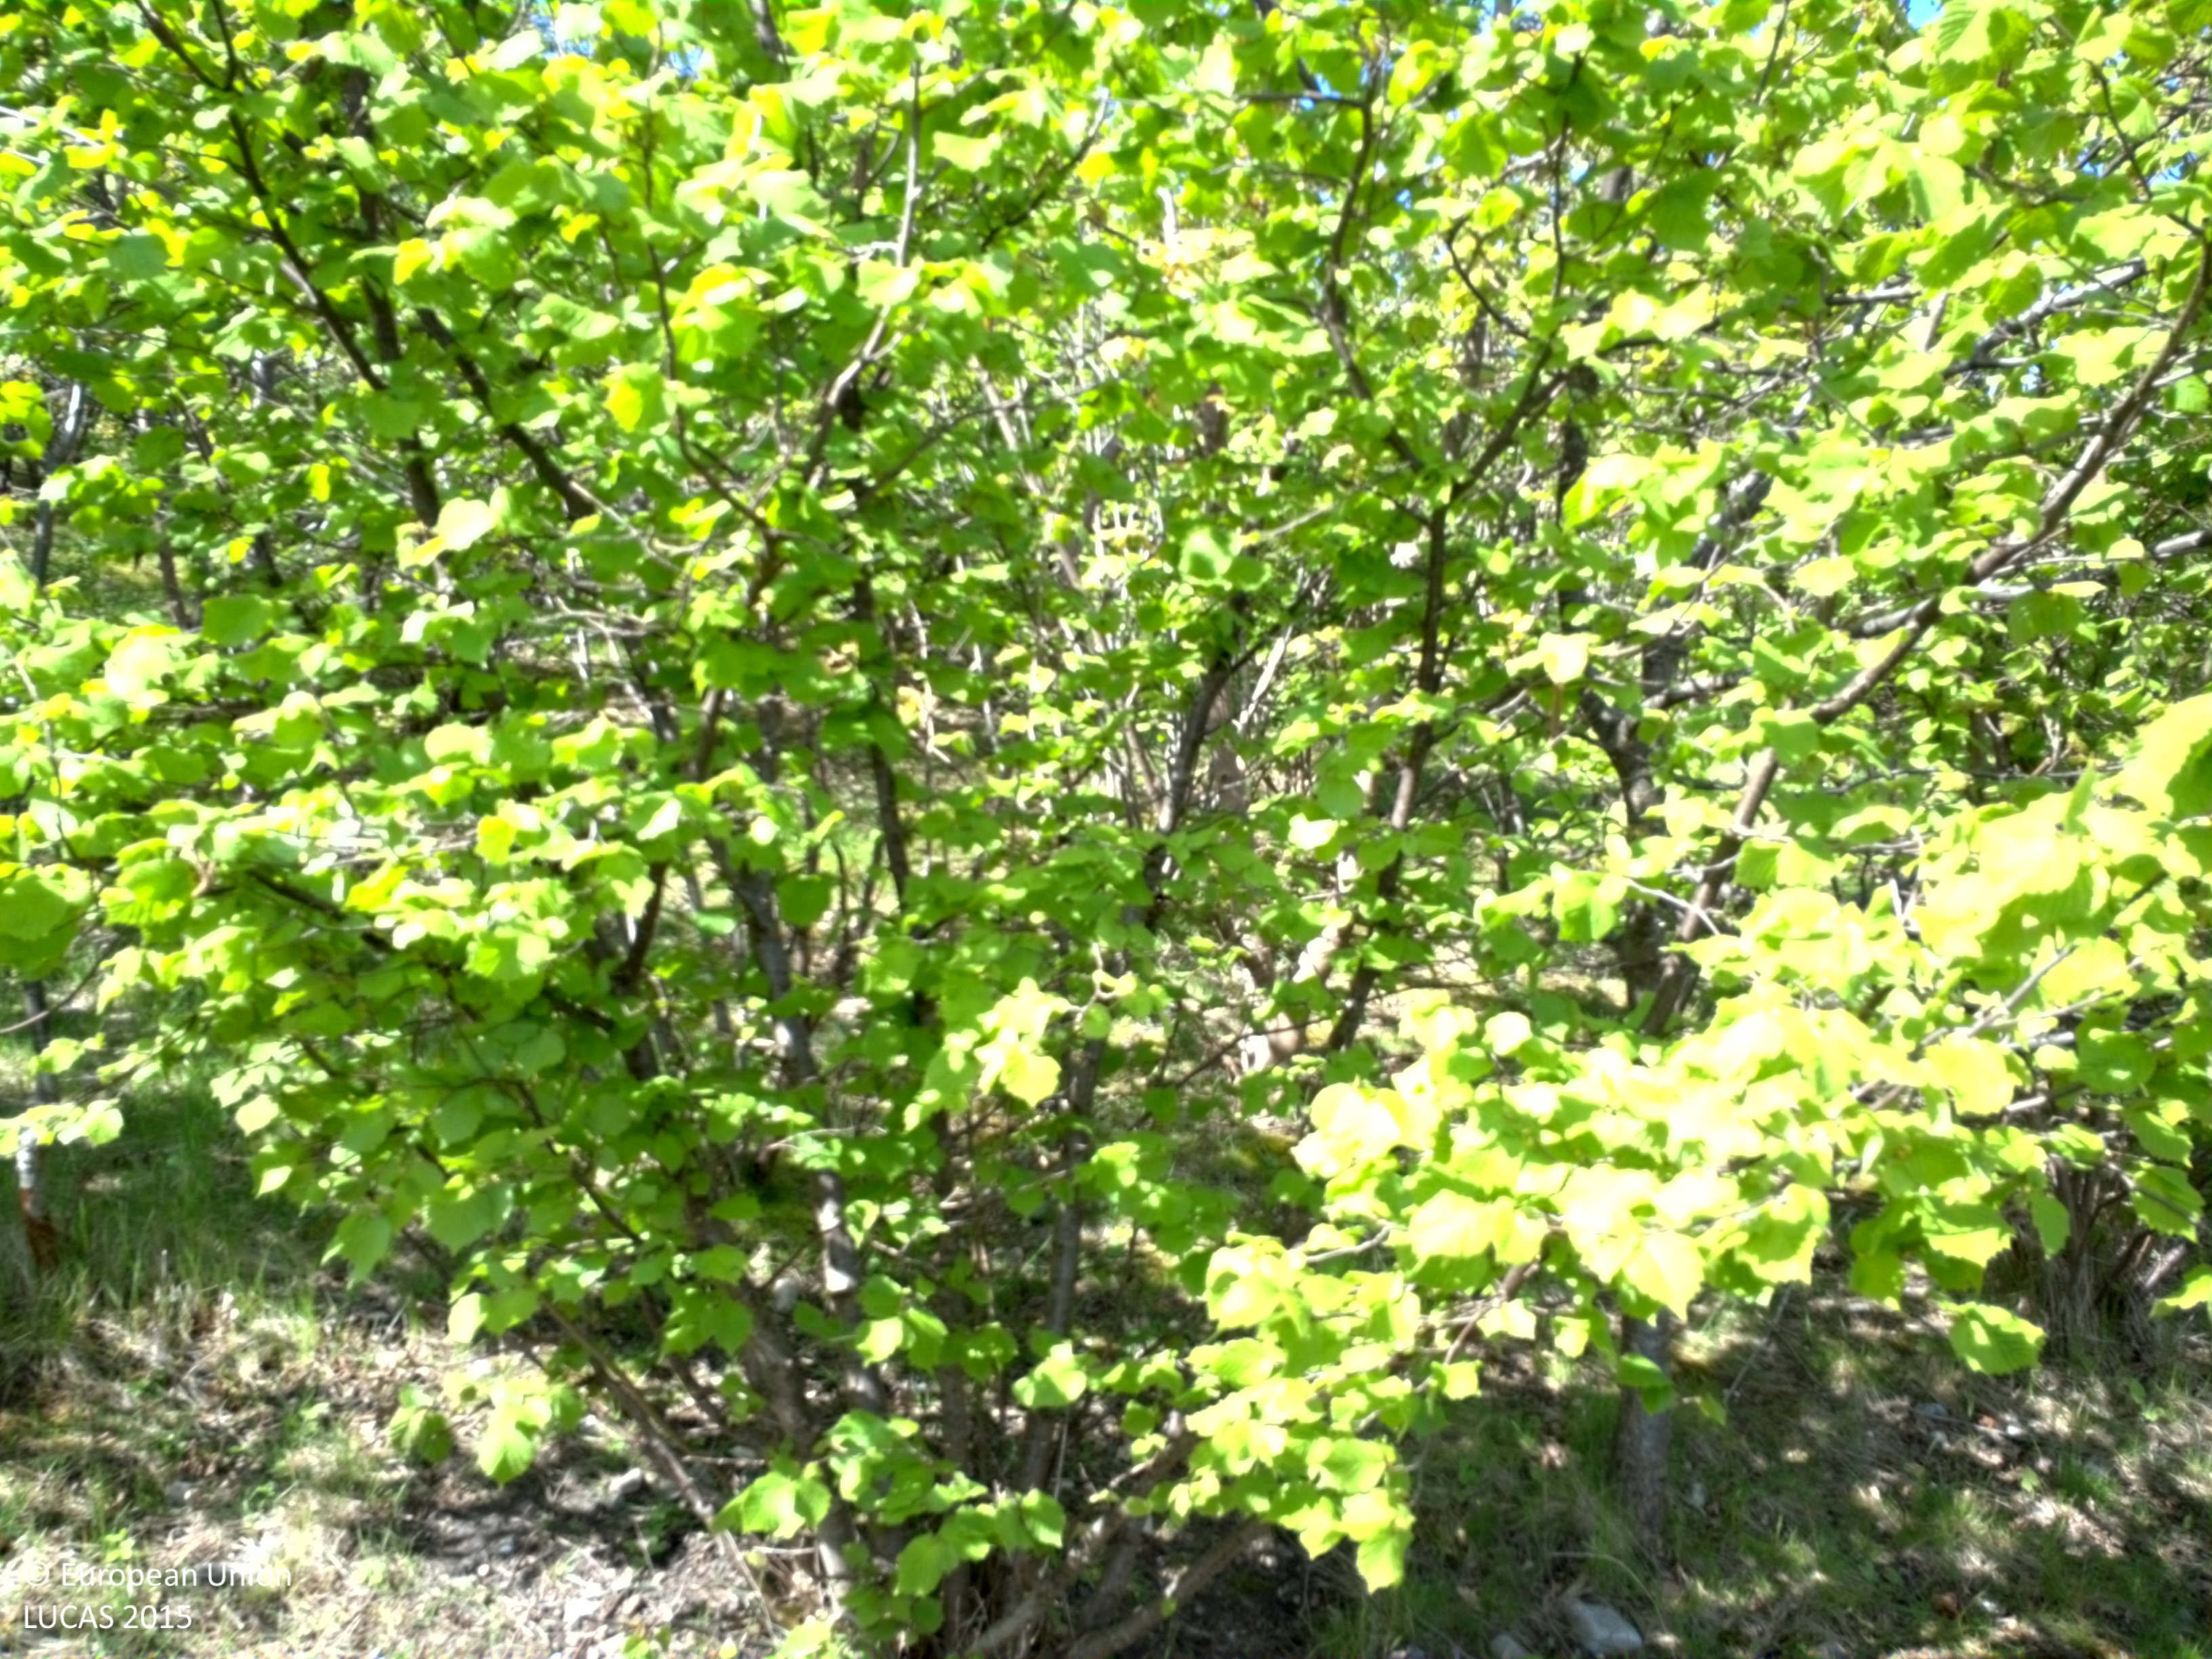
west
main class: Woodland
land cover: Broadleaved woodland
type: mesophytic deciduous forest
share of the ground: 50 - 75 %
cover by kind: broadleaved forest trees 75 %, shrubs 25 %
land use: Semi-natural and natural areas not in use
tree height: < 5 m
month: May
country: SE
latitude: 55.5585
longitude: 13.0262
